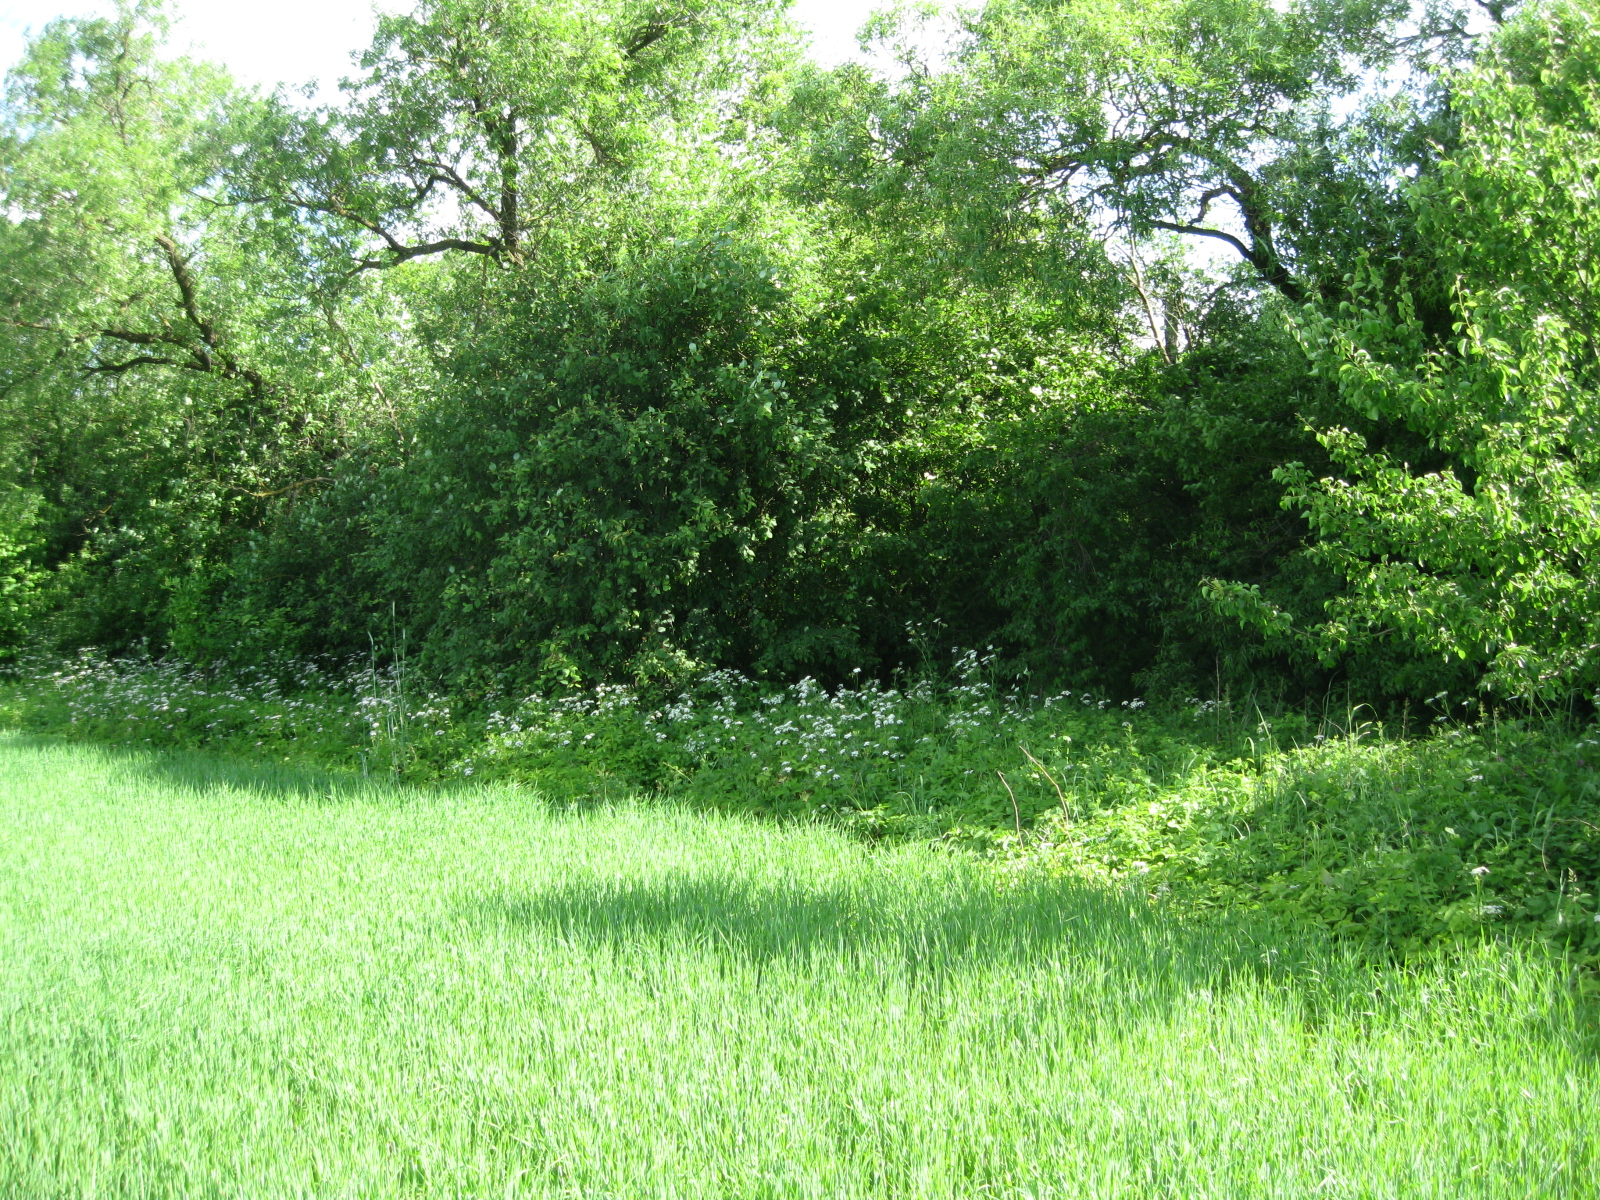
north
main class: Cropland
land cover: Barley
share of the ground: > 75 %
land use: Agriculture (excluding fallow land and kitchen gardens)
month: June
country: LT
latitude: 55.1785
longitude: 23.8266
